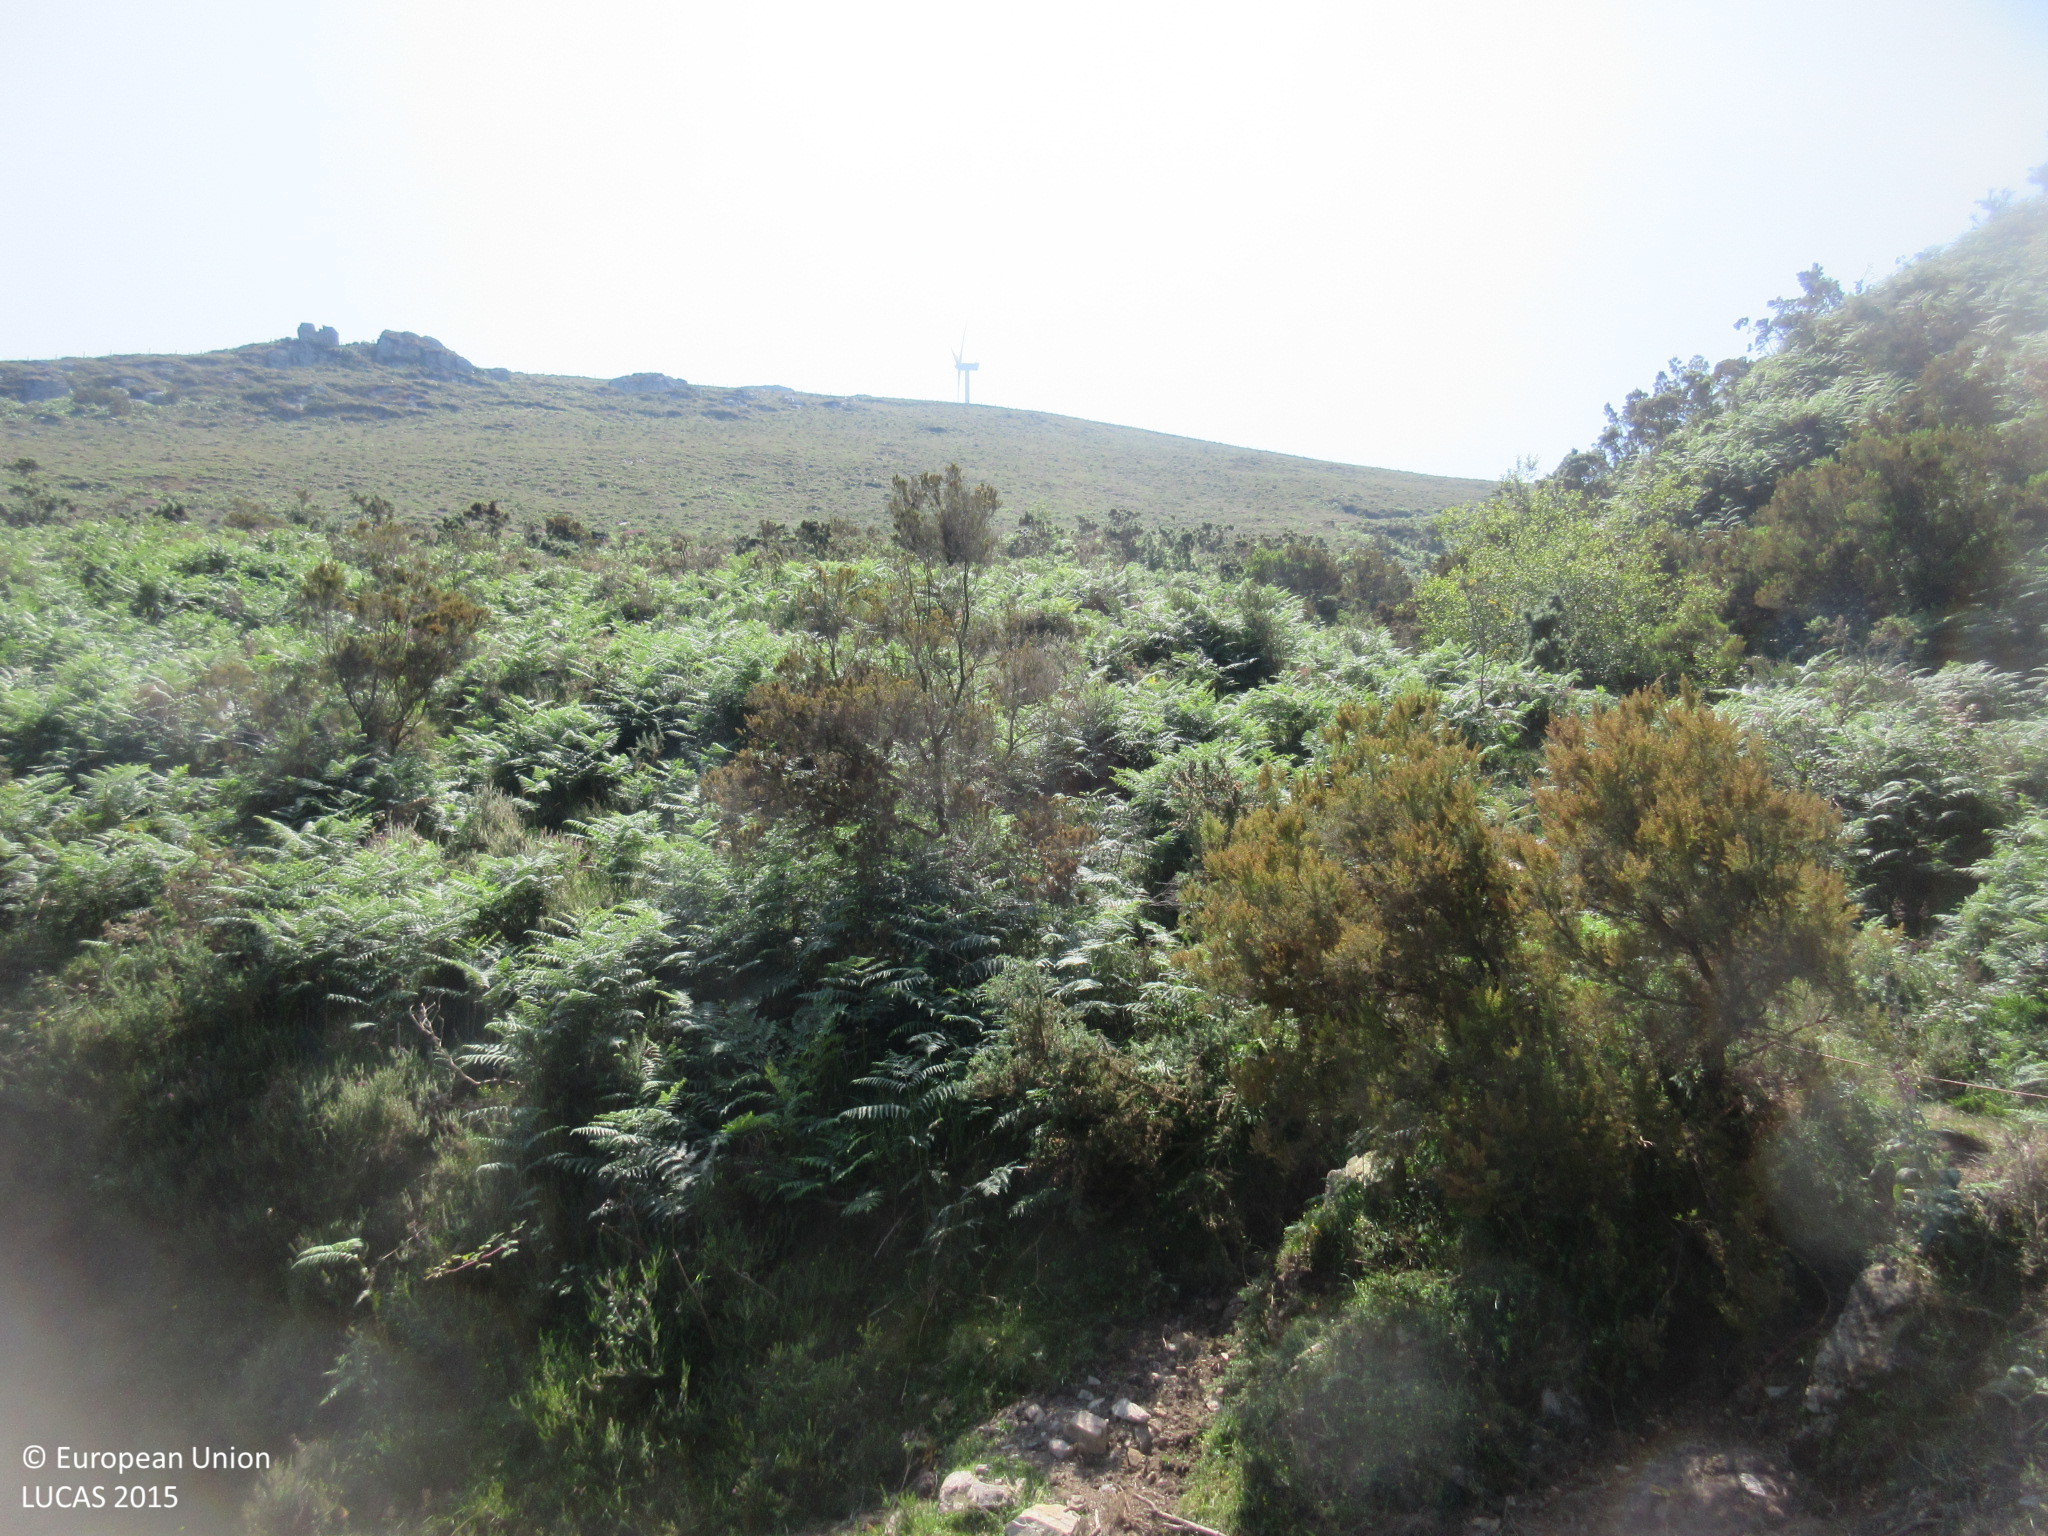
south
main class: Shrubland
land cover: Shrubland without tree cover
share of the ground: > 75 %
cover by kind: shrubs 100 %
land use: Agriculture (excluding fallow land and kitchen gardens)
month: July
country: ES
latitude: 43.4312
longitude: -6.6742
